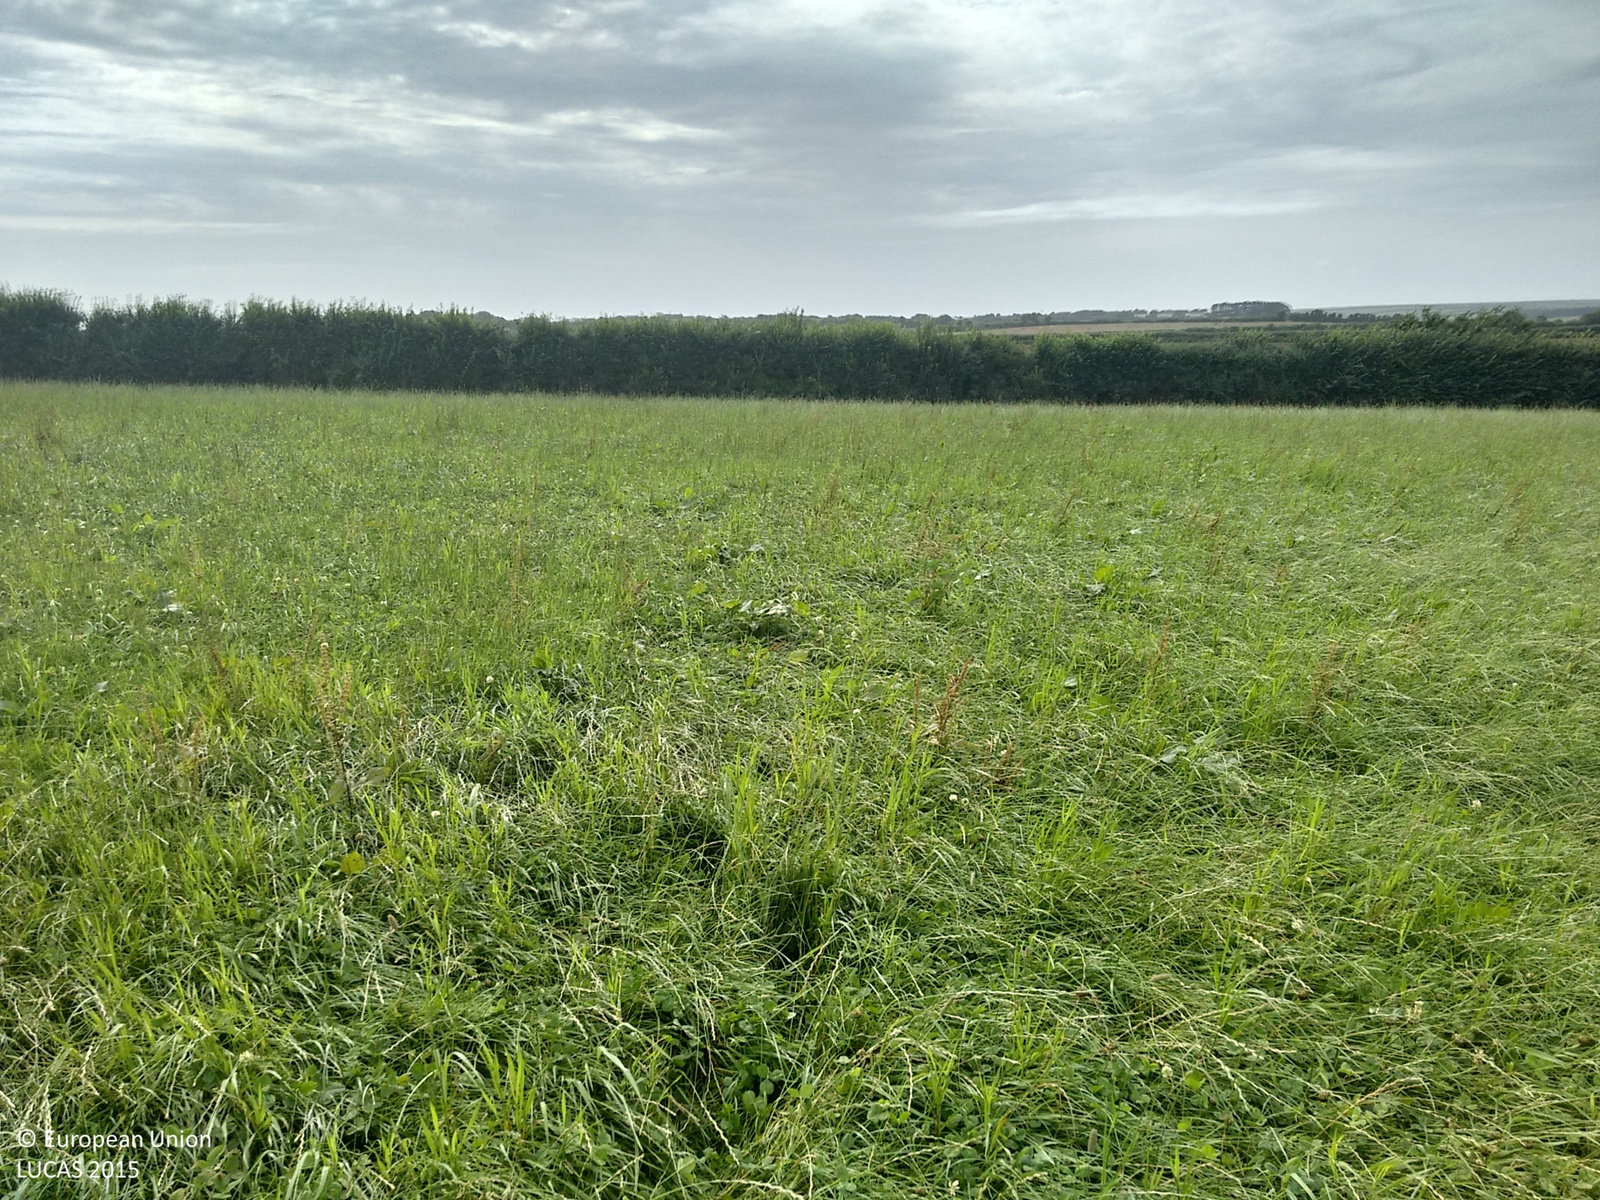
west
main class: Grassland
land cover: Grassland without tree/shrub cover
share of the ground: > 75 %
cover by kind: herbaceous plants 100 %
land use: Agriculture (excluding fallow land and kitchen gardens)
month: August
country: GB
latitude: 50.0517
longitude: -5.2178
